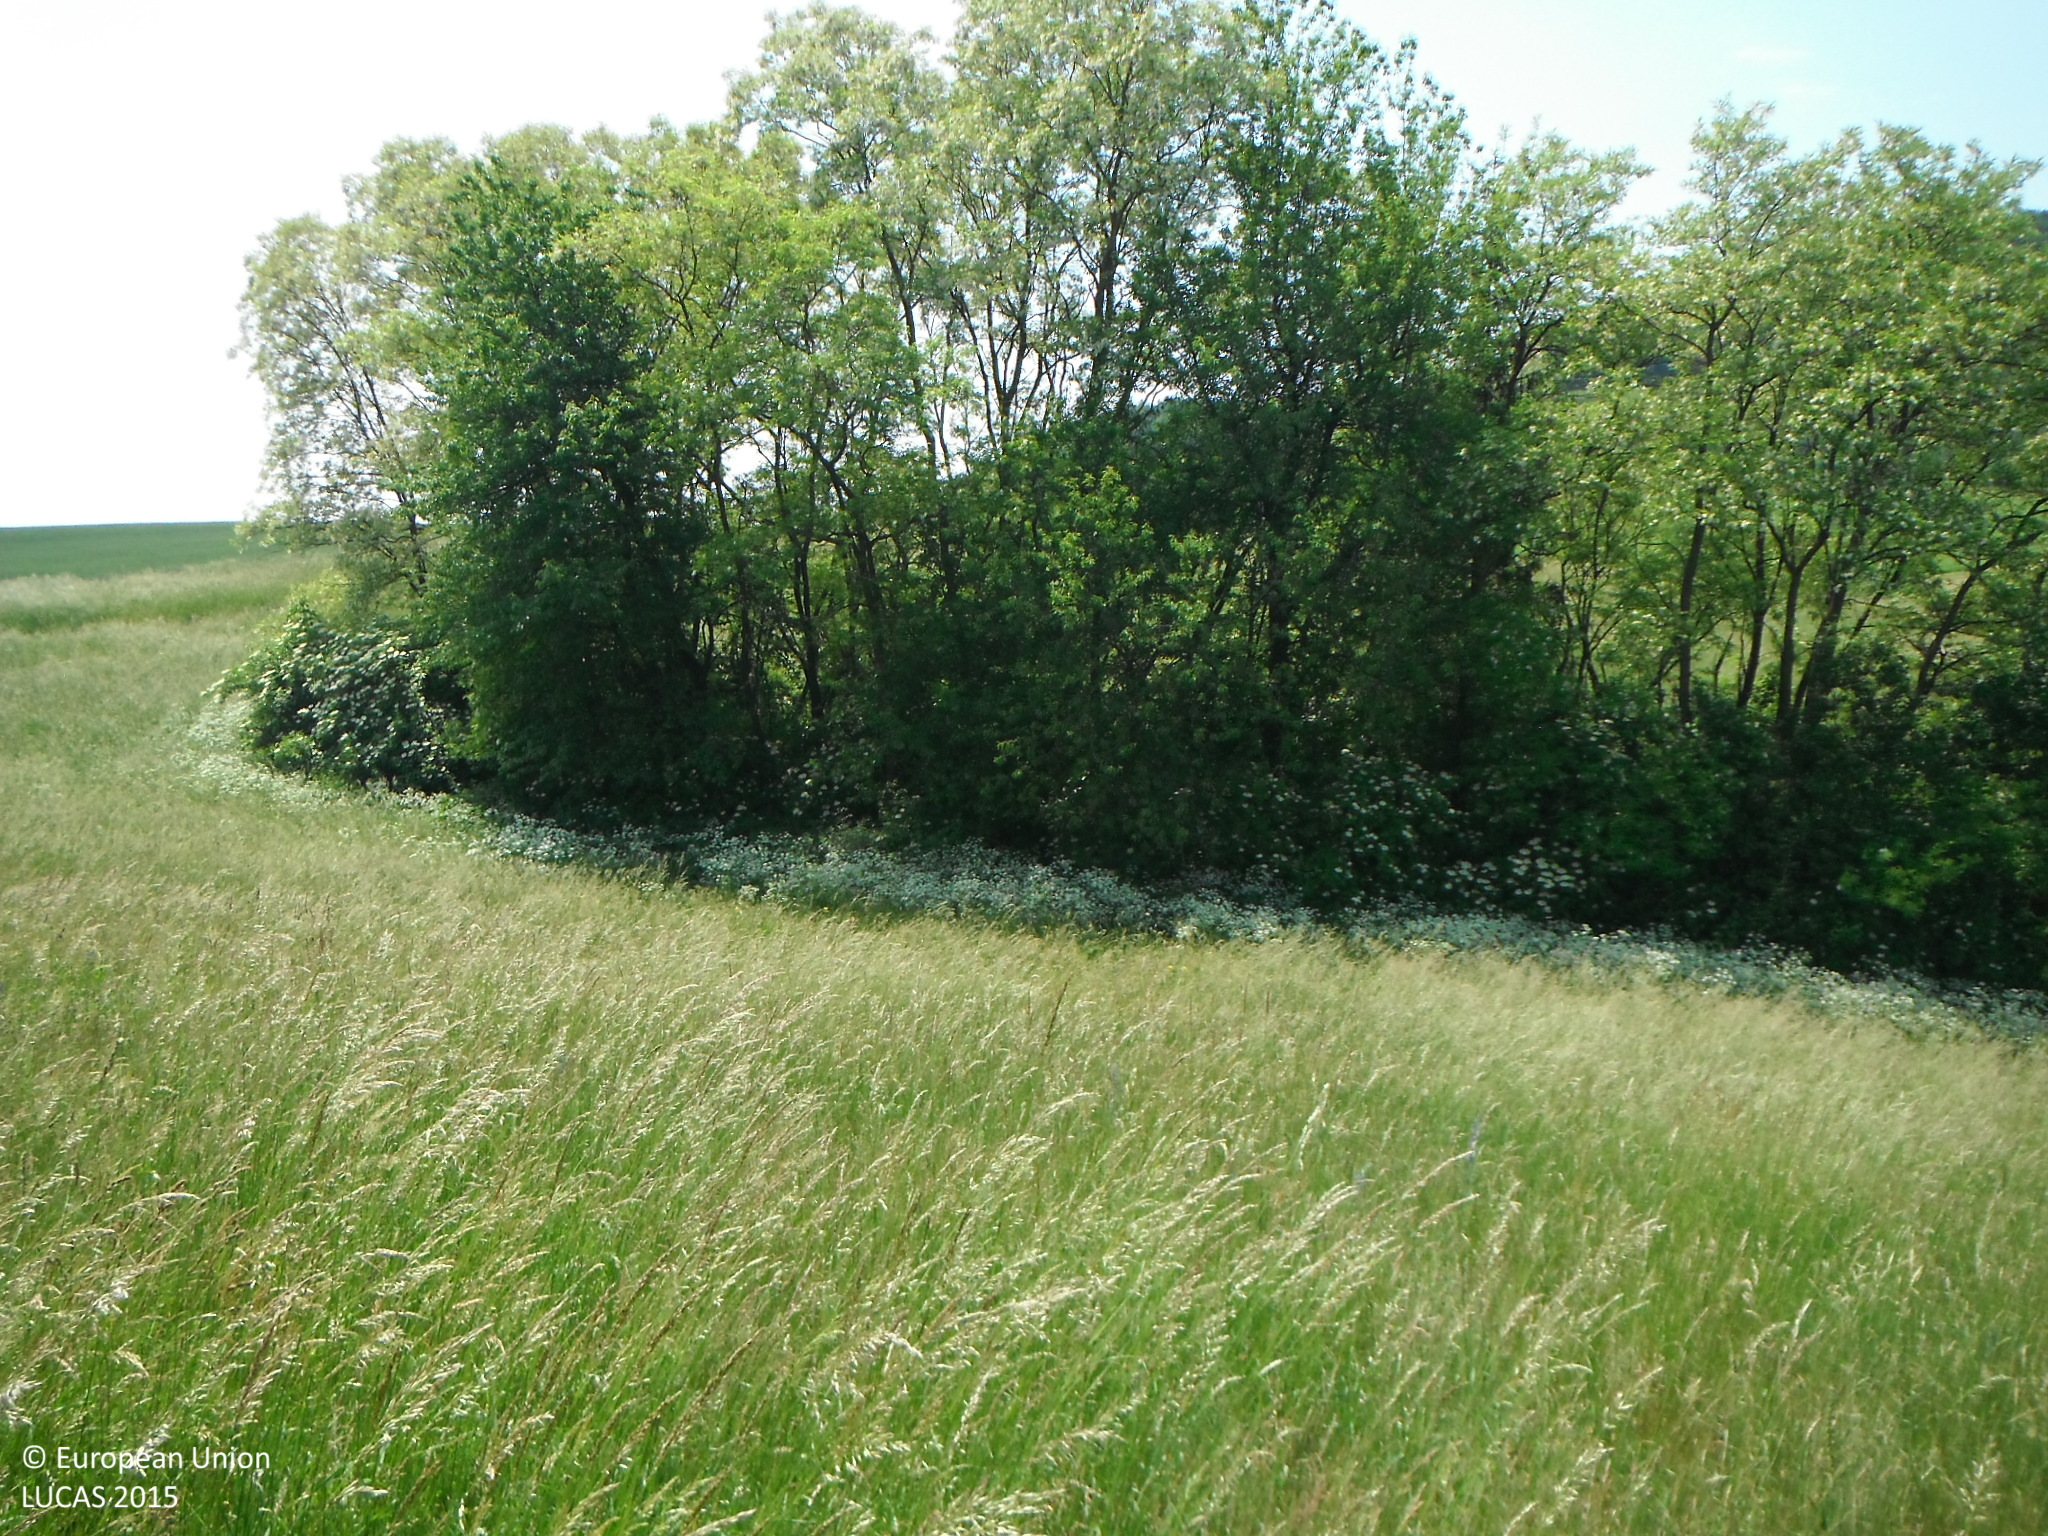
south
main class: Grassland
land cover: Grassland without tree/shrub cover
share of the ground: > 75 %
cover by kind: herbaceous plants 100 %
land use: Agriculture (excluding fallow land and kitchen gardens)
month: June
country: SK
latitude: 48.7077
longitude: 19.1955
